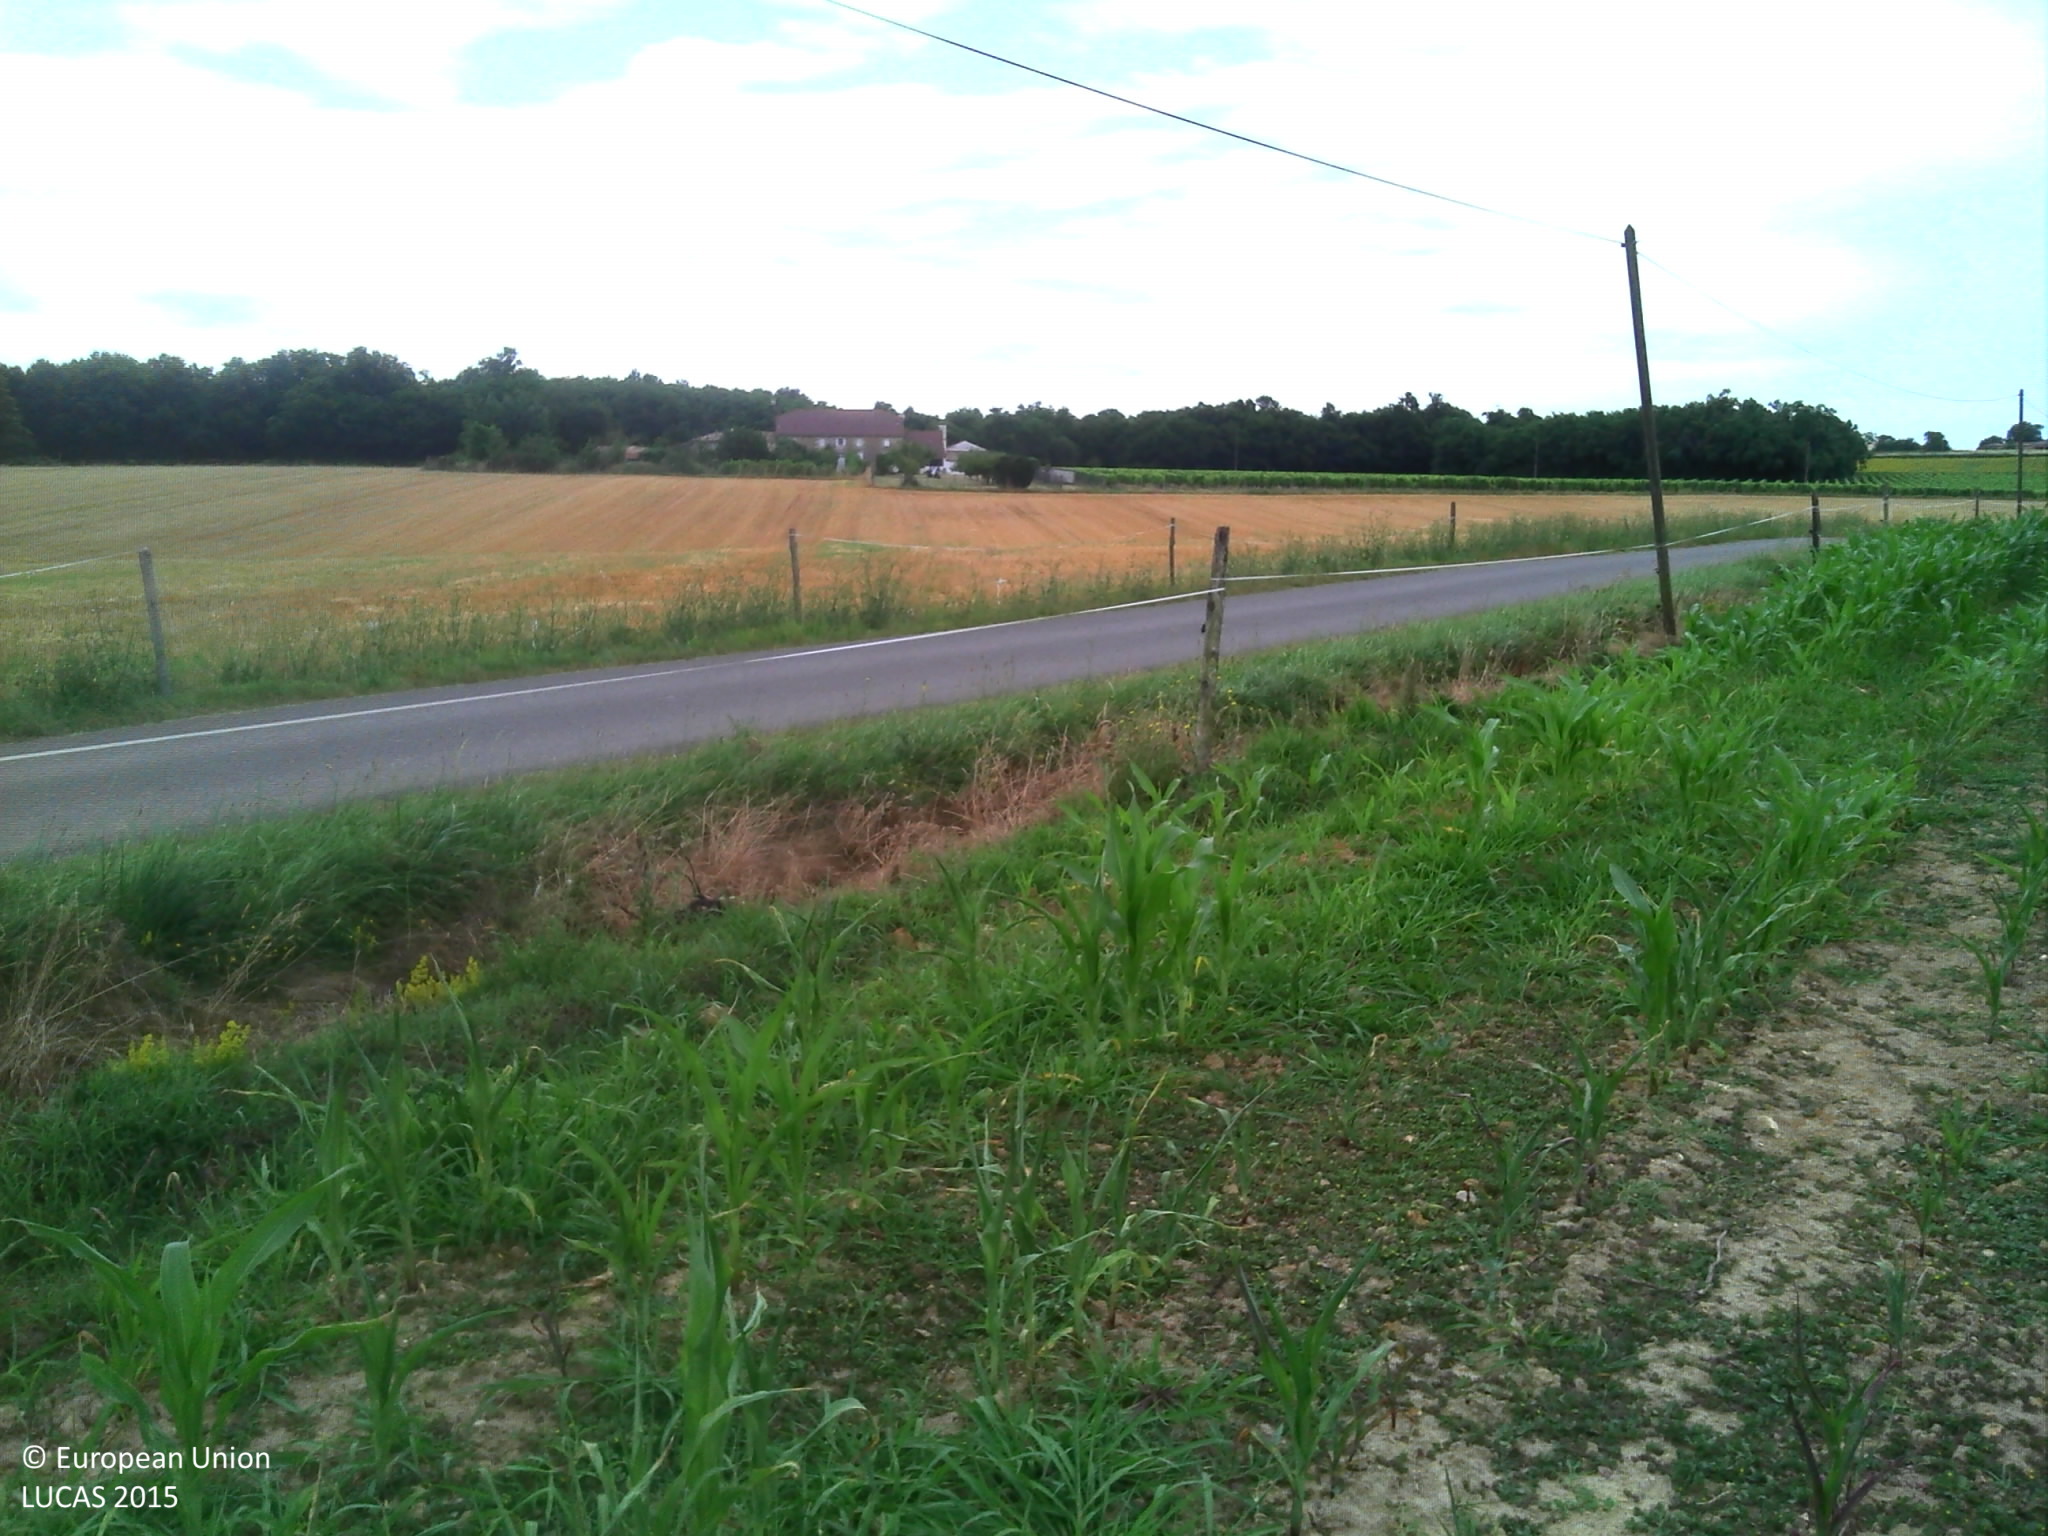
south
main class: Cropland
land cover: Maize
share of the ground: 50 - 75 %
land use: Agriculture (excluding fallow land and kitchen gardens)
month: July
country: FR
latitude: 45.4700
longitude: -0.6779
